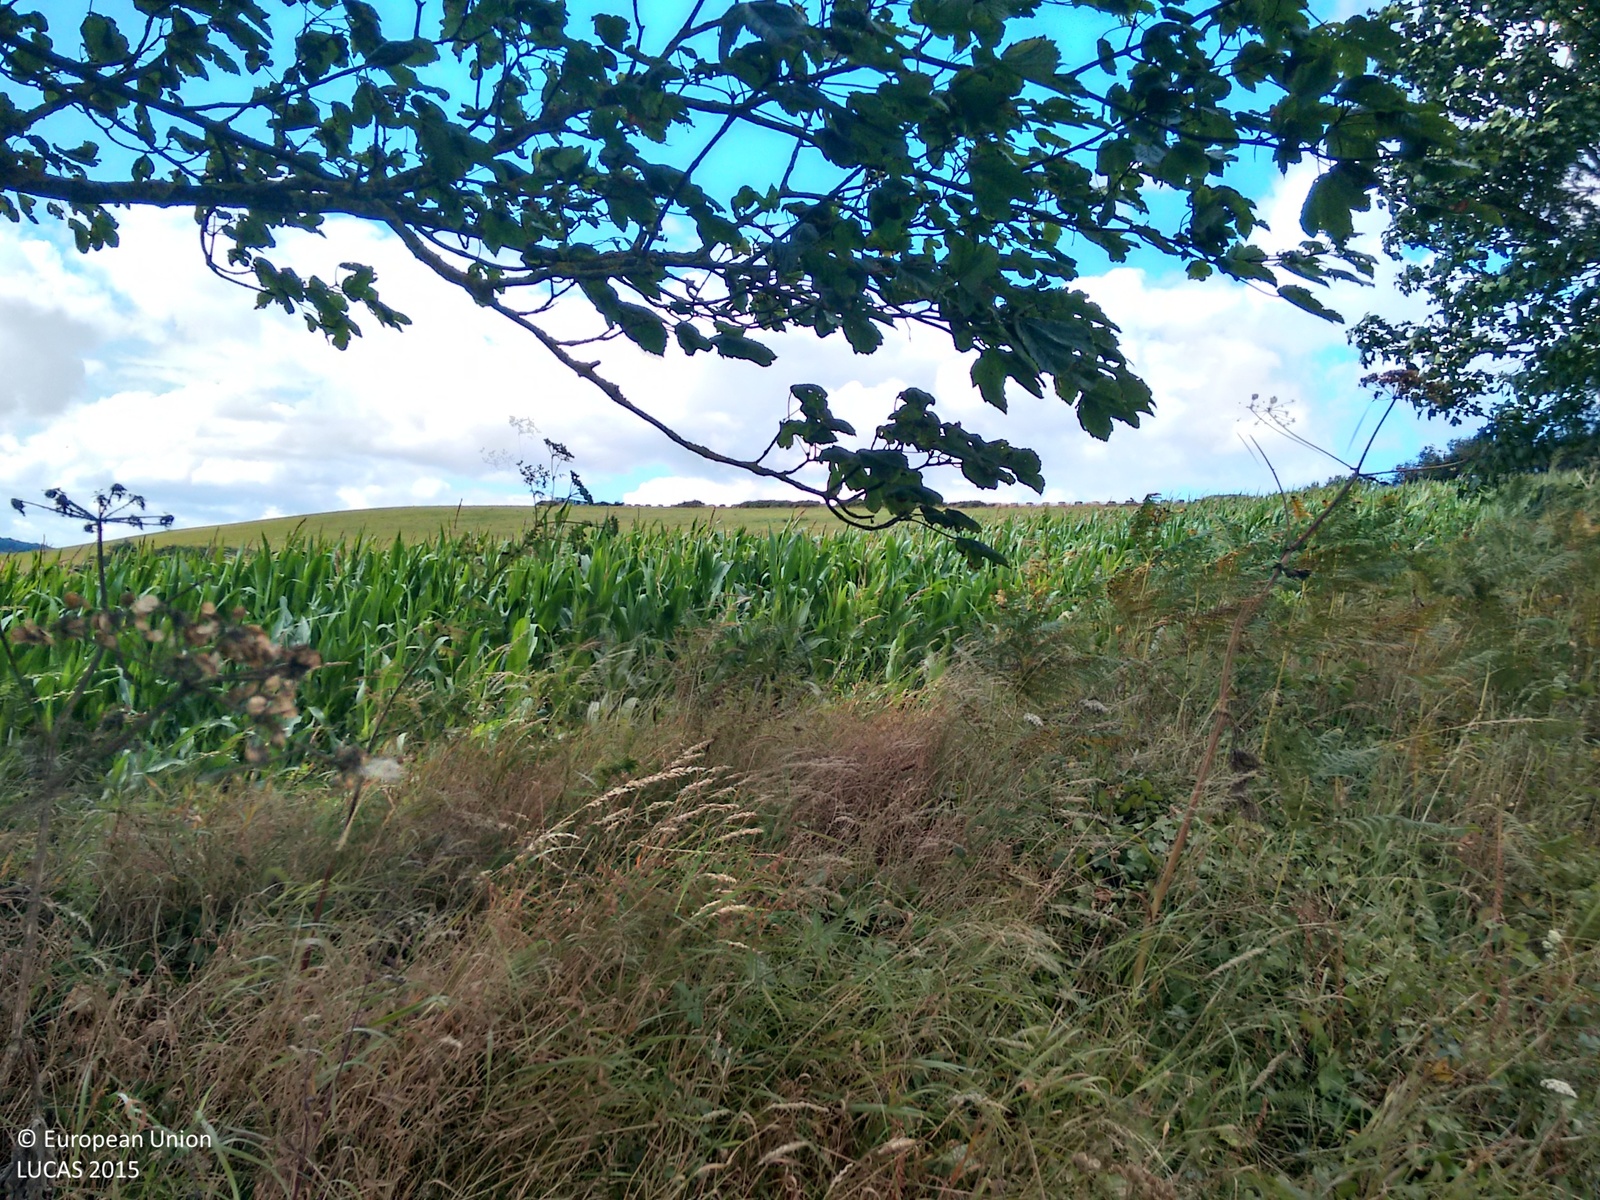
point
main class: Cropland
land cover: Maize
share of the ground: > 75 %
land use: Agriculture (excluding fallow land and kitchen gardens)
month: July
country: GB
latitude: 50.6401
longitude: -3.3013
